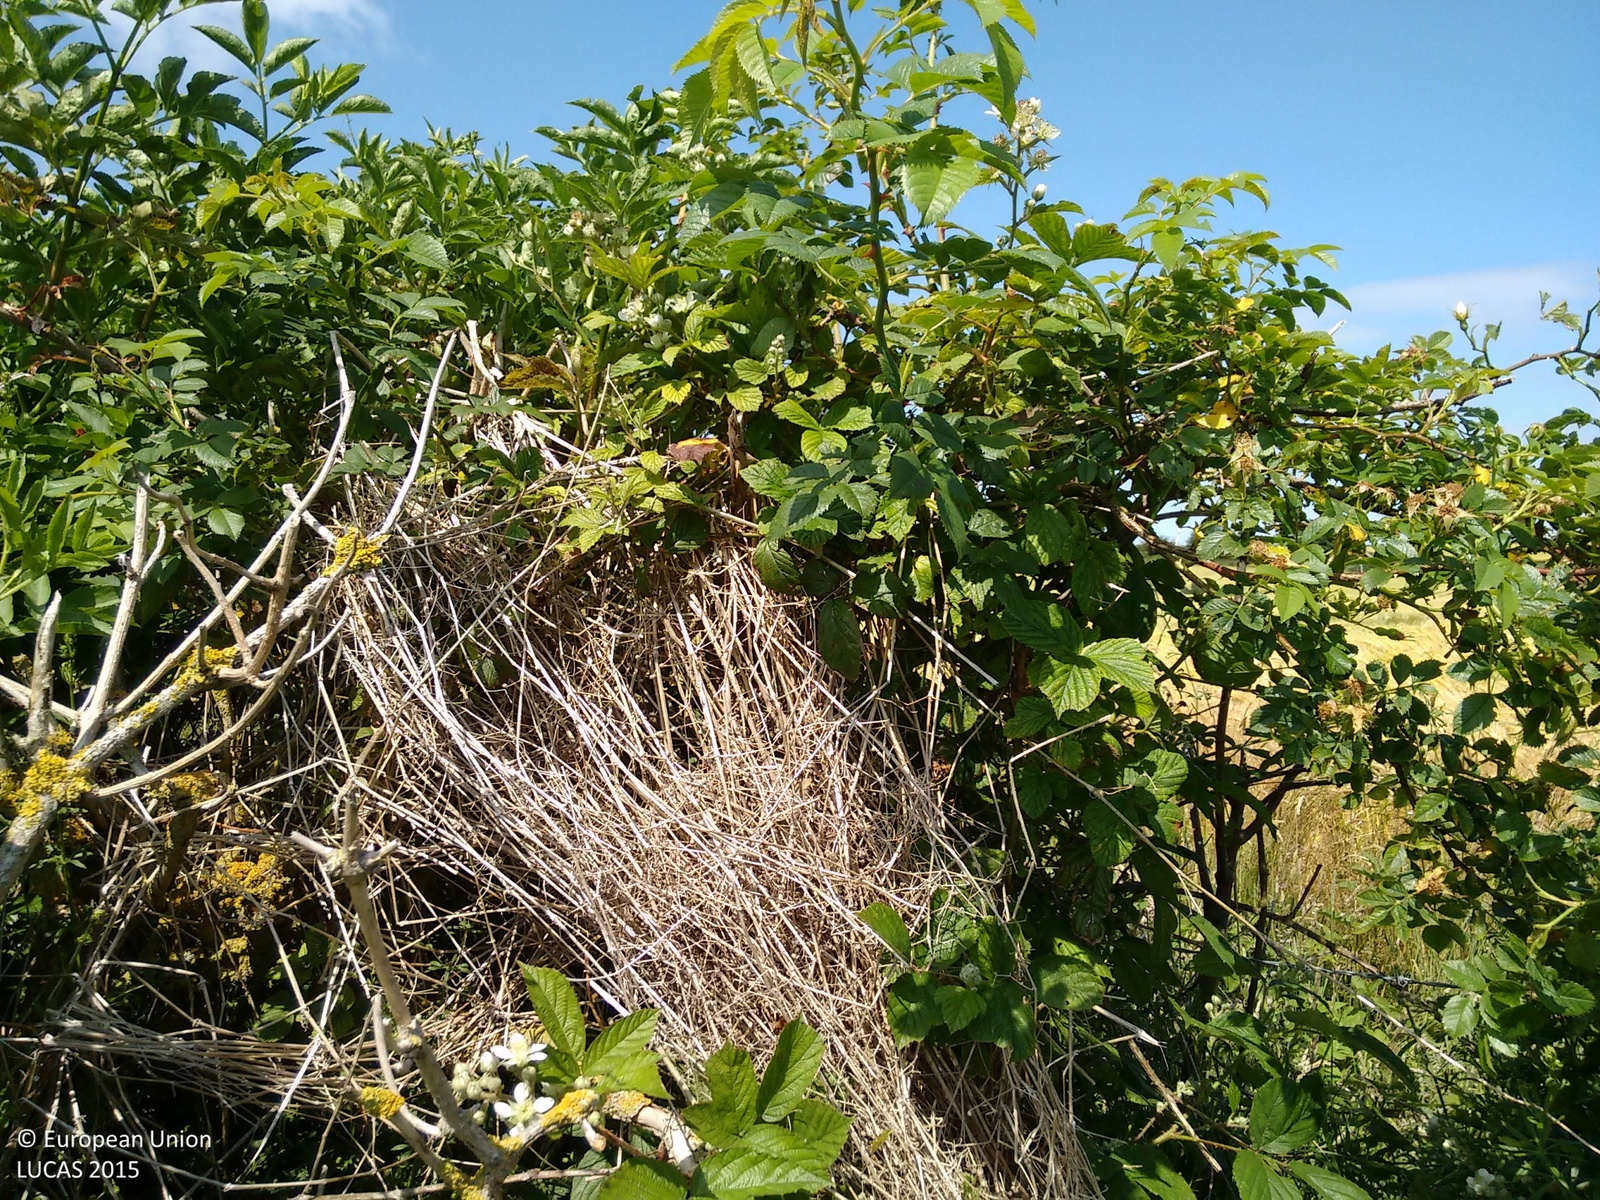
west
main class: Cropland
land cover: Barley
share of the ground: > 75 %
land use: Agriculture (excluding fallow land and kitchen gardens)
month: July
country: GB
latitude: 54.5536
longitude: -0.9727
